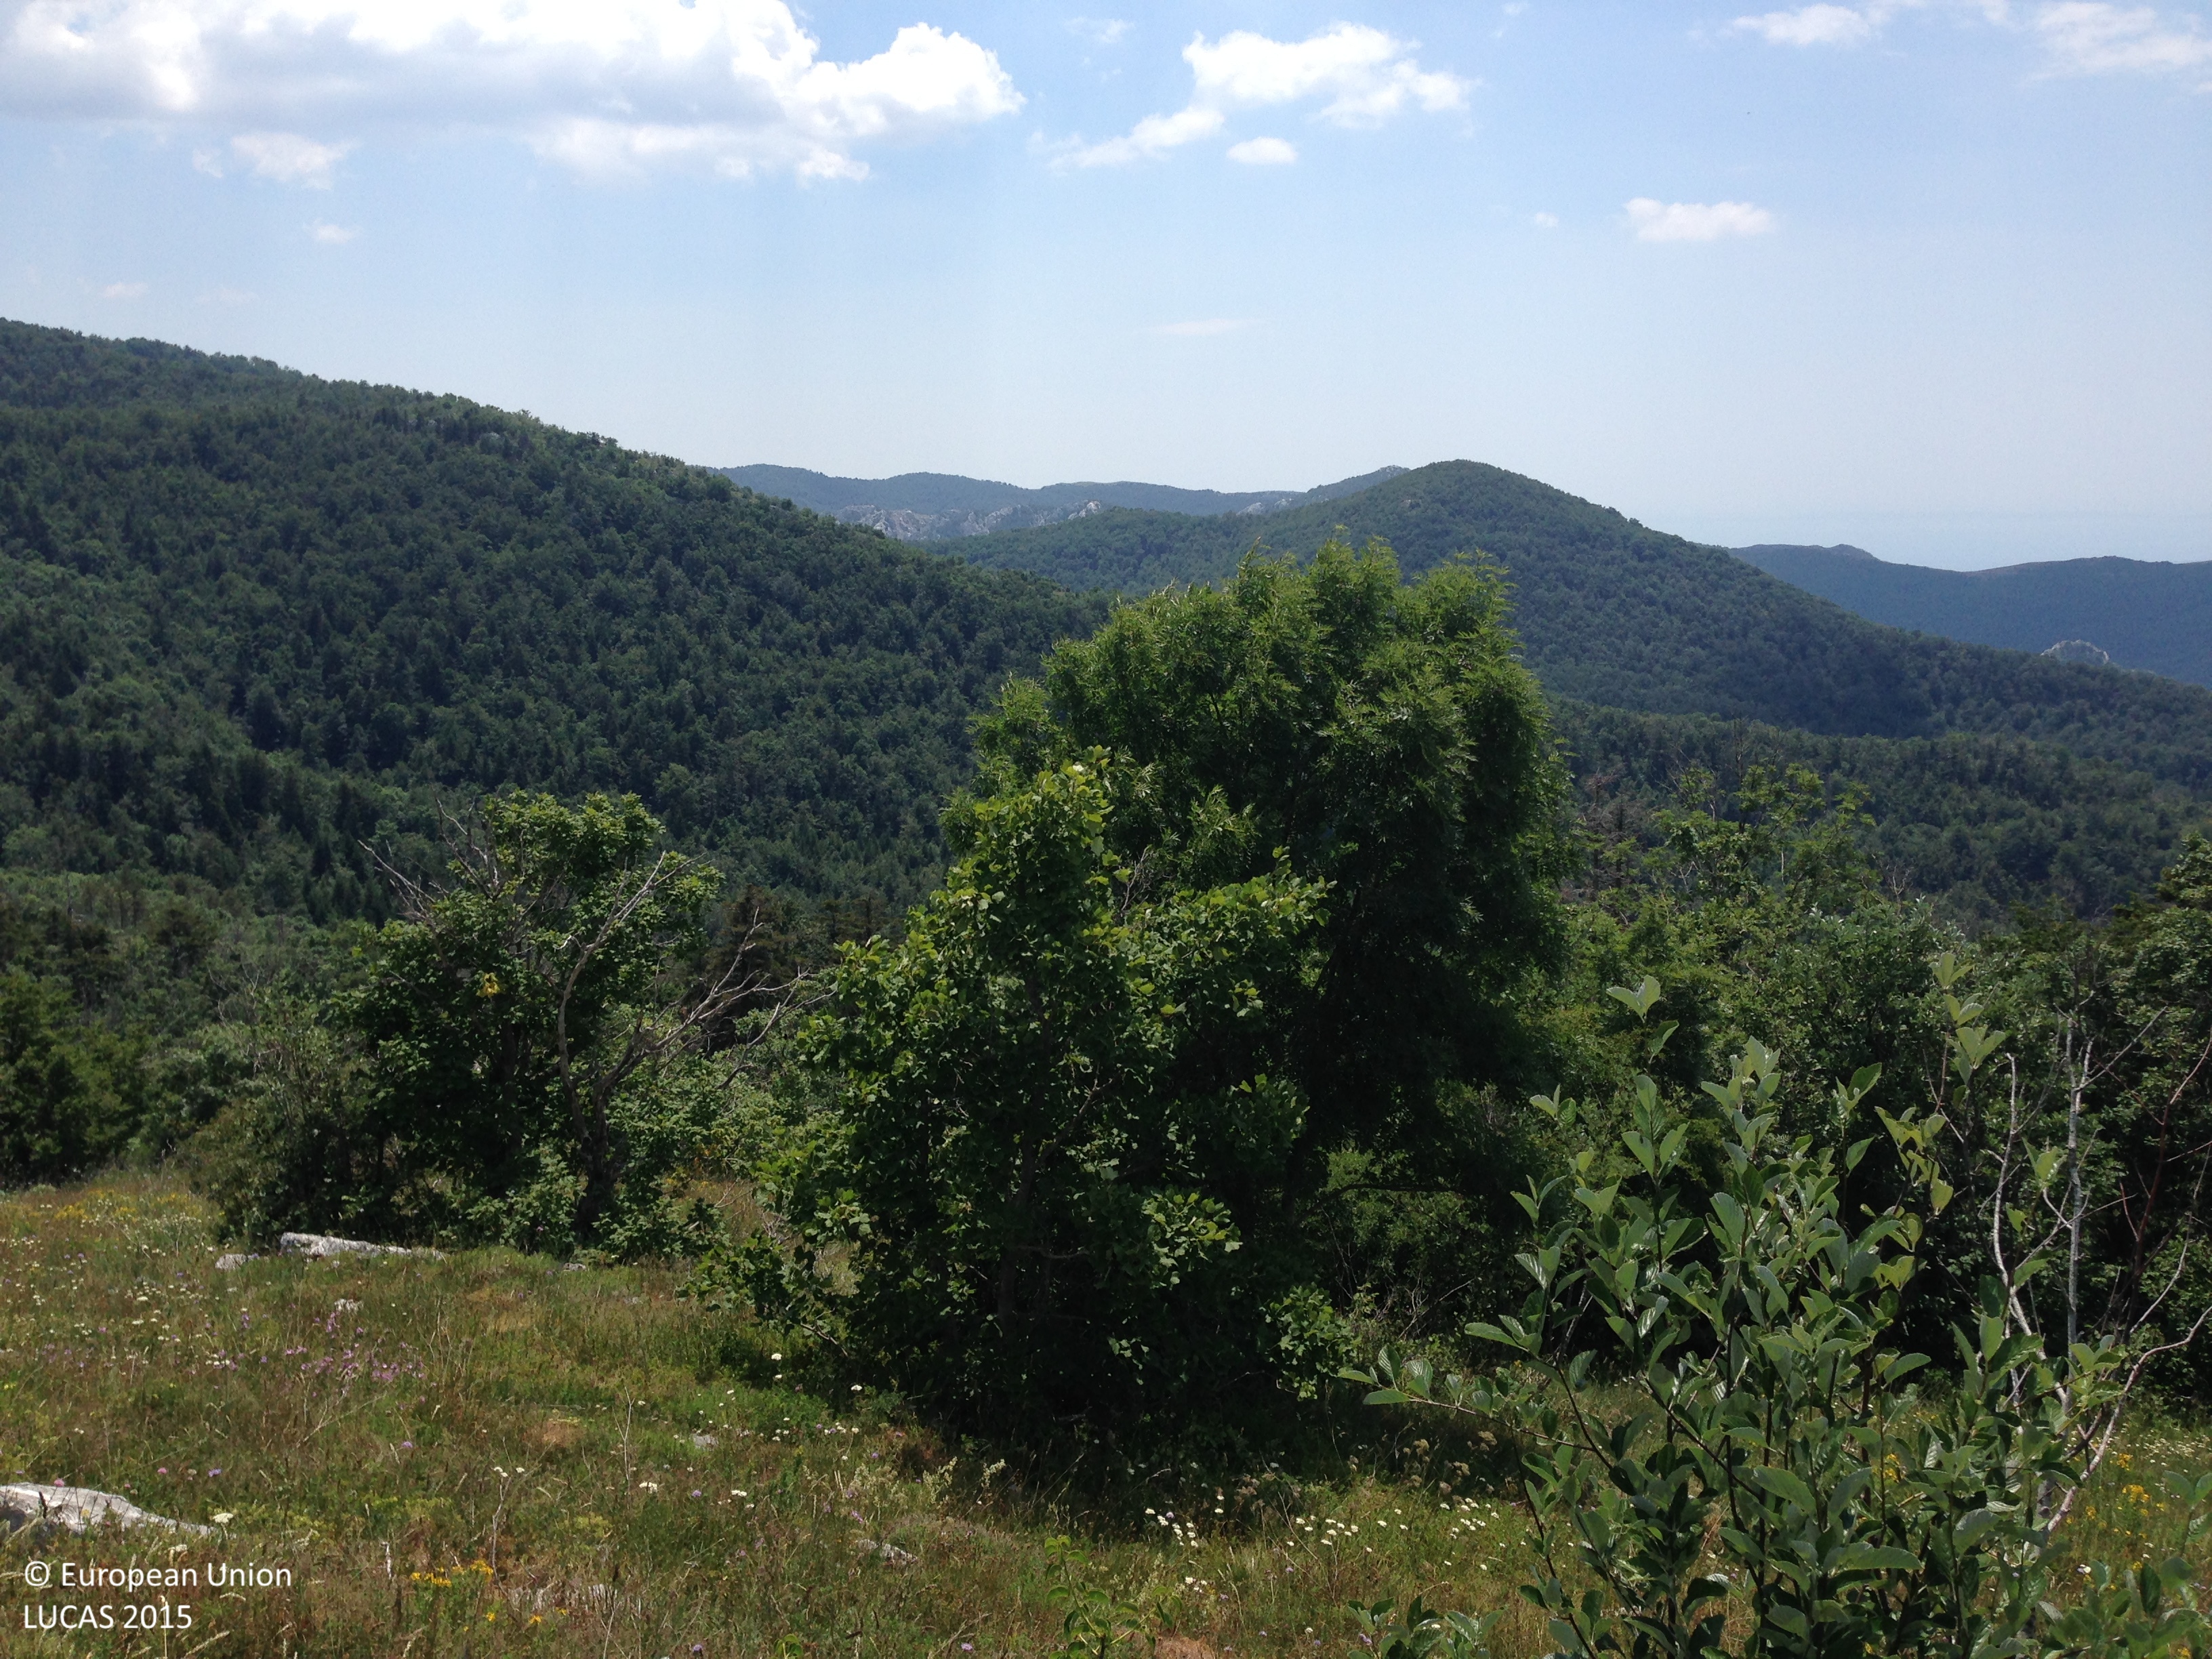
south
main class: Shrubland
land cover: Shrubland with sparse tree cover
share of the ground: 25 - 50 %
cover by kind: shrubs 35 %, herbaceous plants 35 %, consolidated bare surface 20 %, broadleaved forest trees 5 %, unconsolidated bare surface 5 %
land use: Semi-natural and natural areas not in use
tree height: < 5 m
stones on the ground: < 10 %
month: July
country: HR
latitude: 44.5843
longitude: 15.1447
